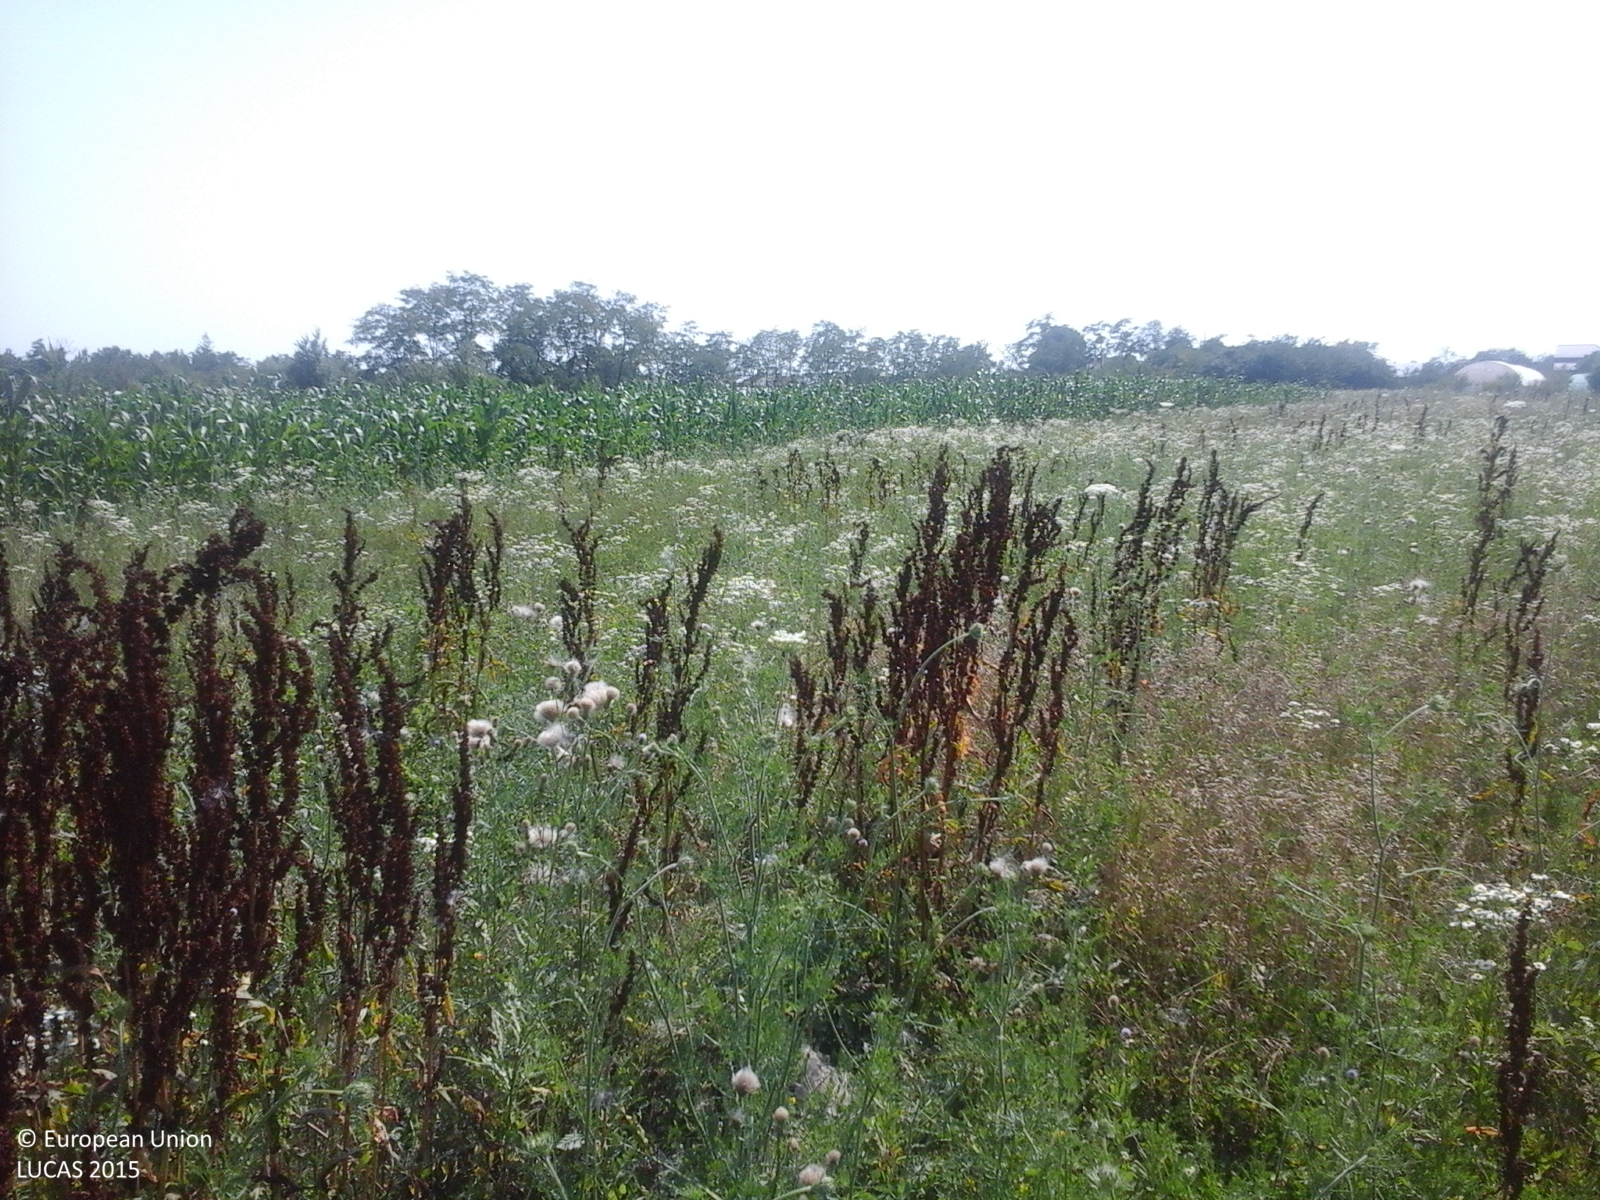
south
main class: Grassland
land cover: Spontaneously vegetated surfaces
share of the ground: > 75 %
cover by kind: herbaceous plants 100 %
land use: Fallow land
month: July
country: RO
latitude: 44.6750
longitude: 25.4186
